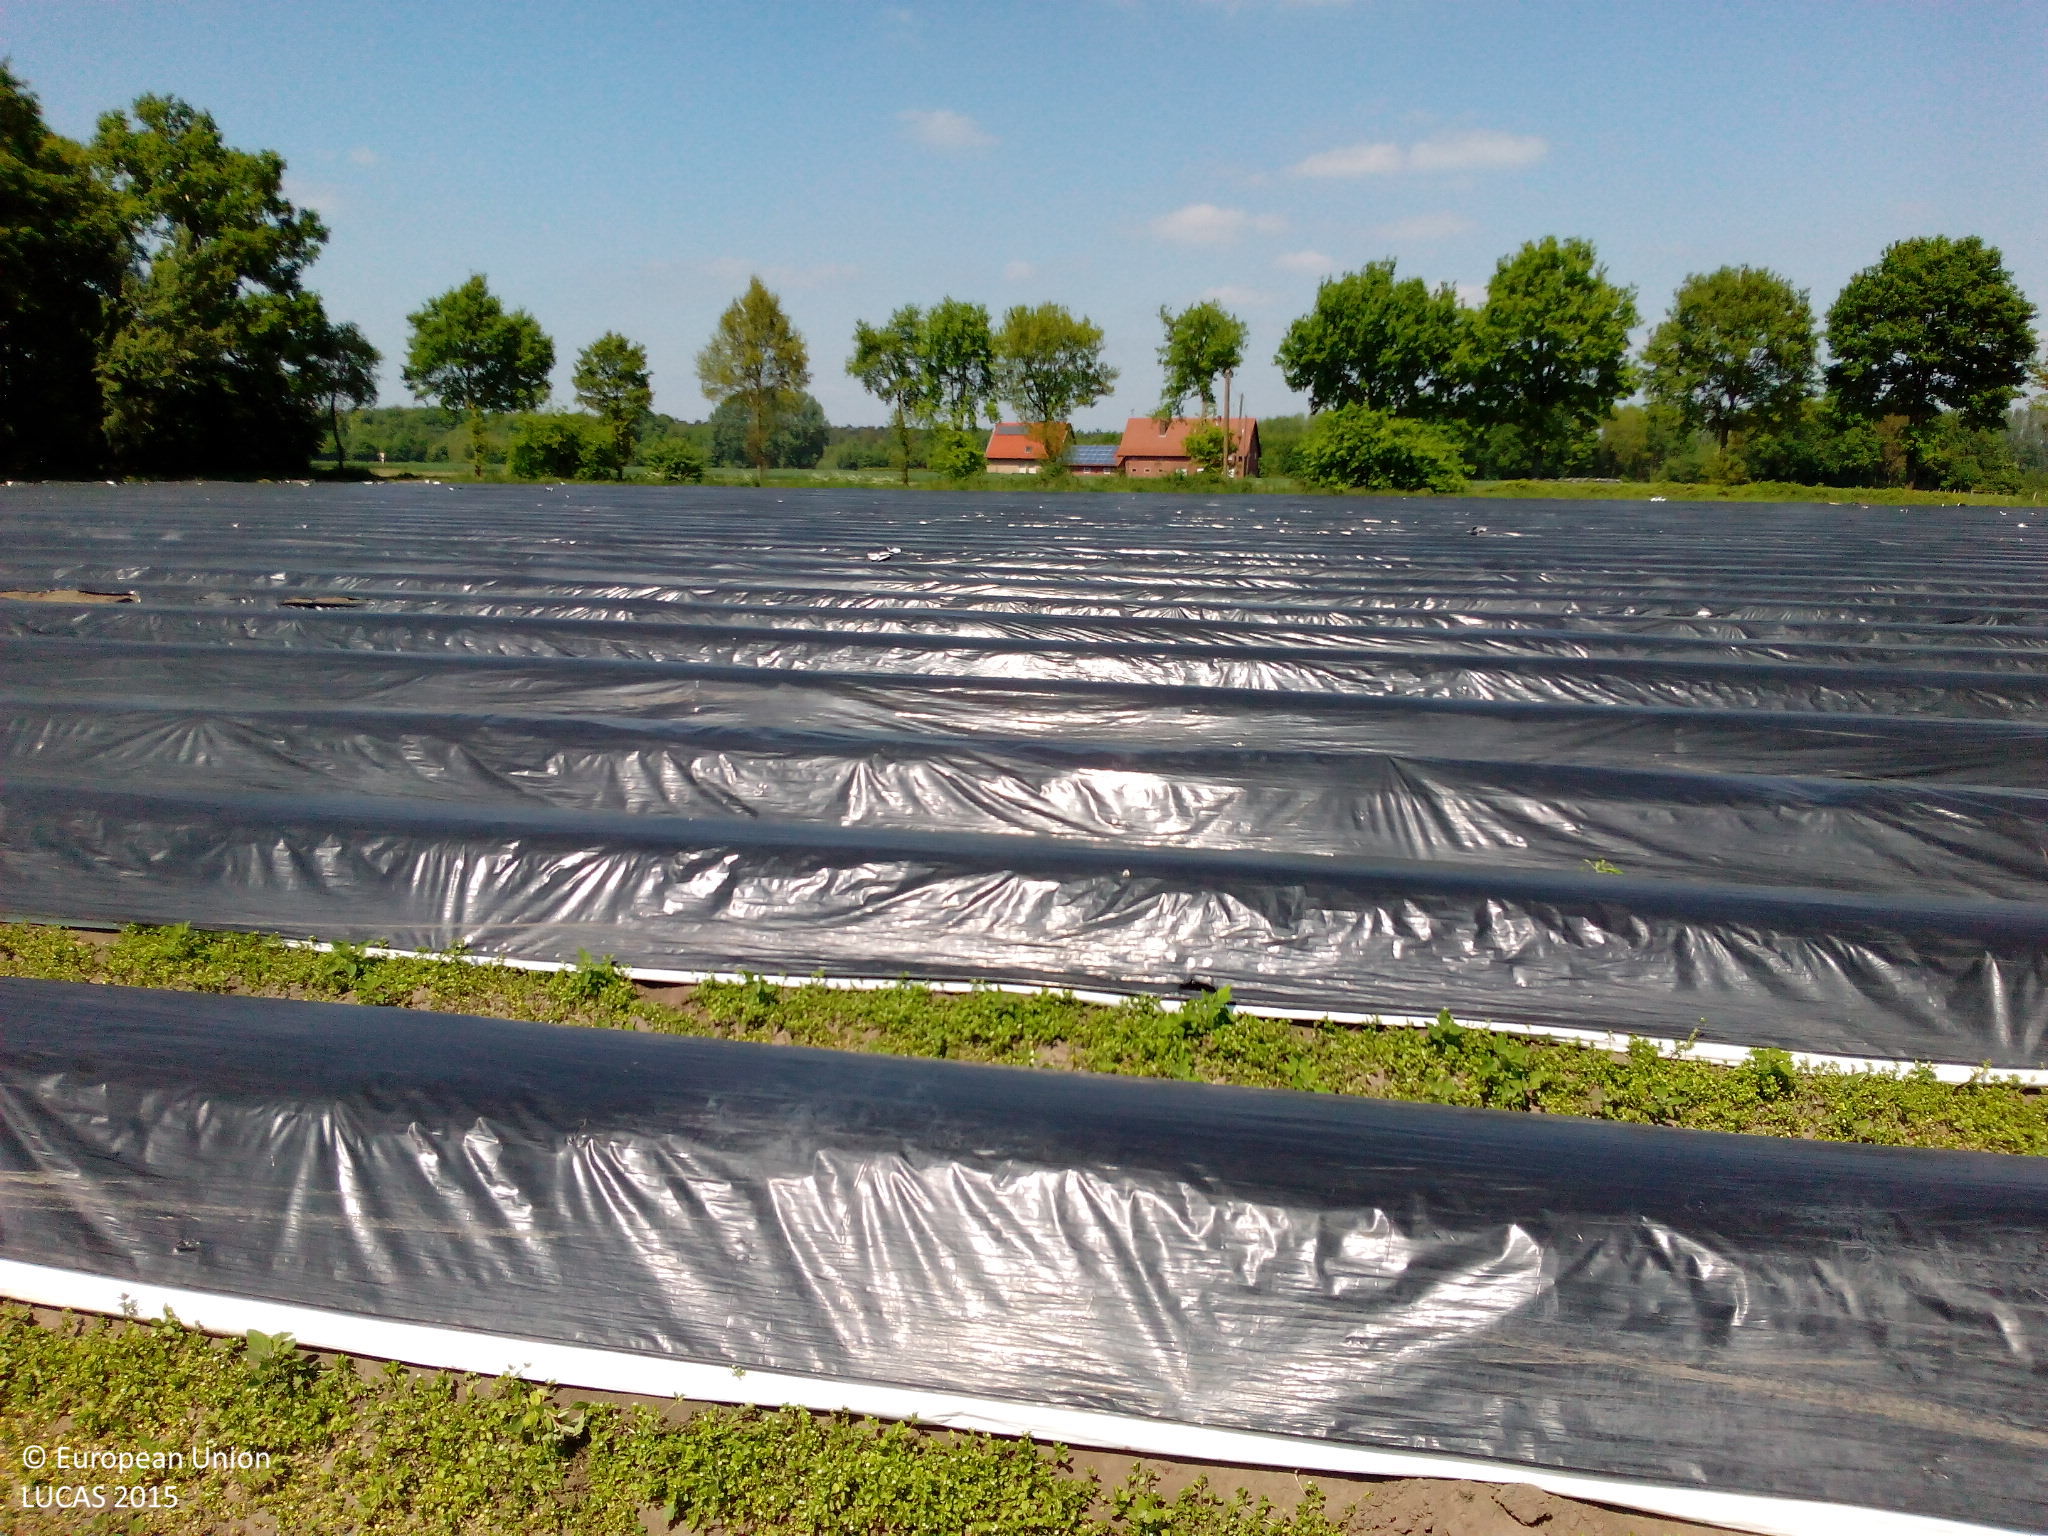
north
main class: Cropland
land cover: Other fresh vegetables
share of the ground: < 10 %
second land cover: Spontaneously vegetated surfaces
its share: 50 - 75 %
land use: Agriculture (excluding fallow land and kitchen gardens)
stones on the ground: < 10 %
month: May
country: DE
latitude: 51.9477
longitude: 8.0363
